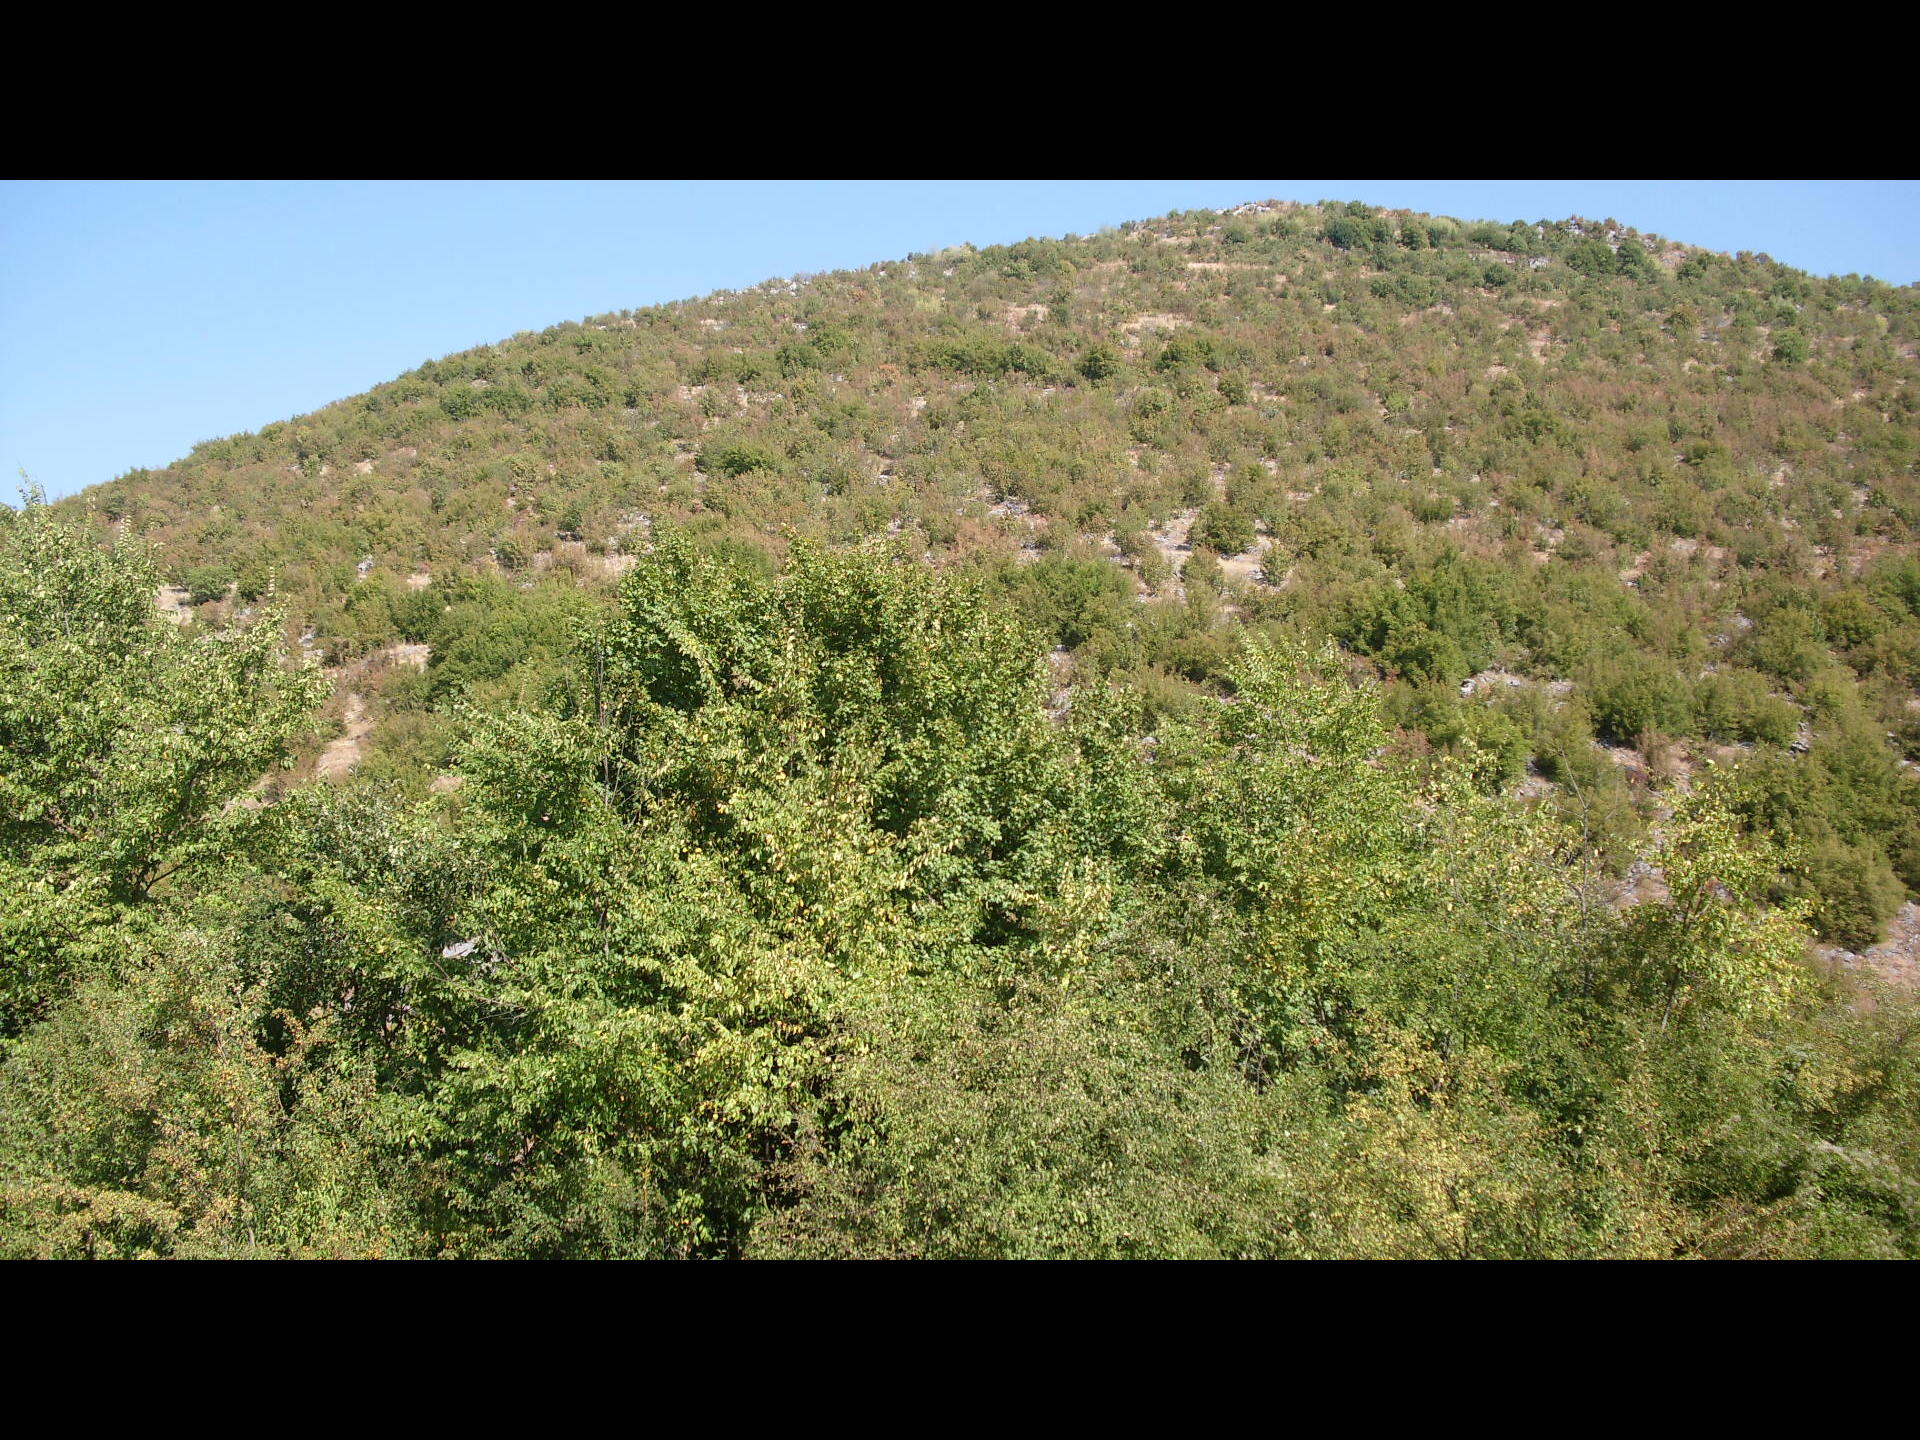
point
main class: Woodland
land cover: Broadleaved woodland
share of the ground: > 75 %
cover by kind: broadleaved forest trees 60 %, shrubs 40 %
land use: Forestry
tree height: < 5 m
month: August
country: BG
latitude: 43.2456
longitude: 23.3535
